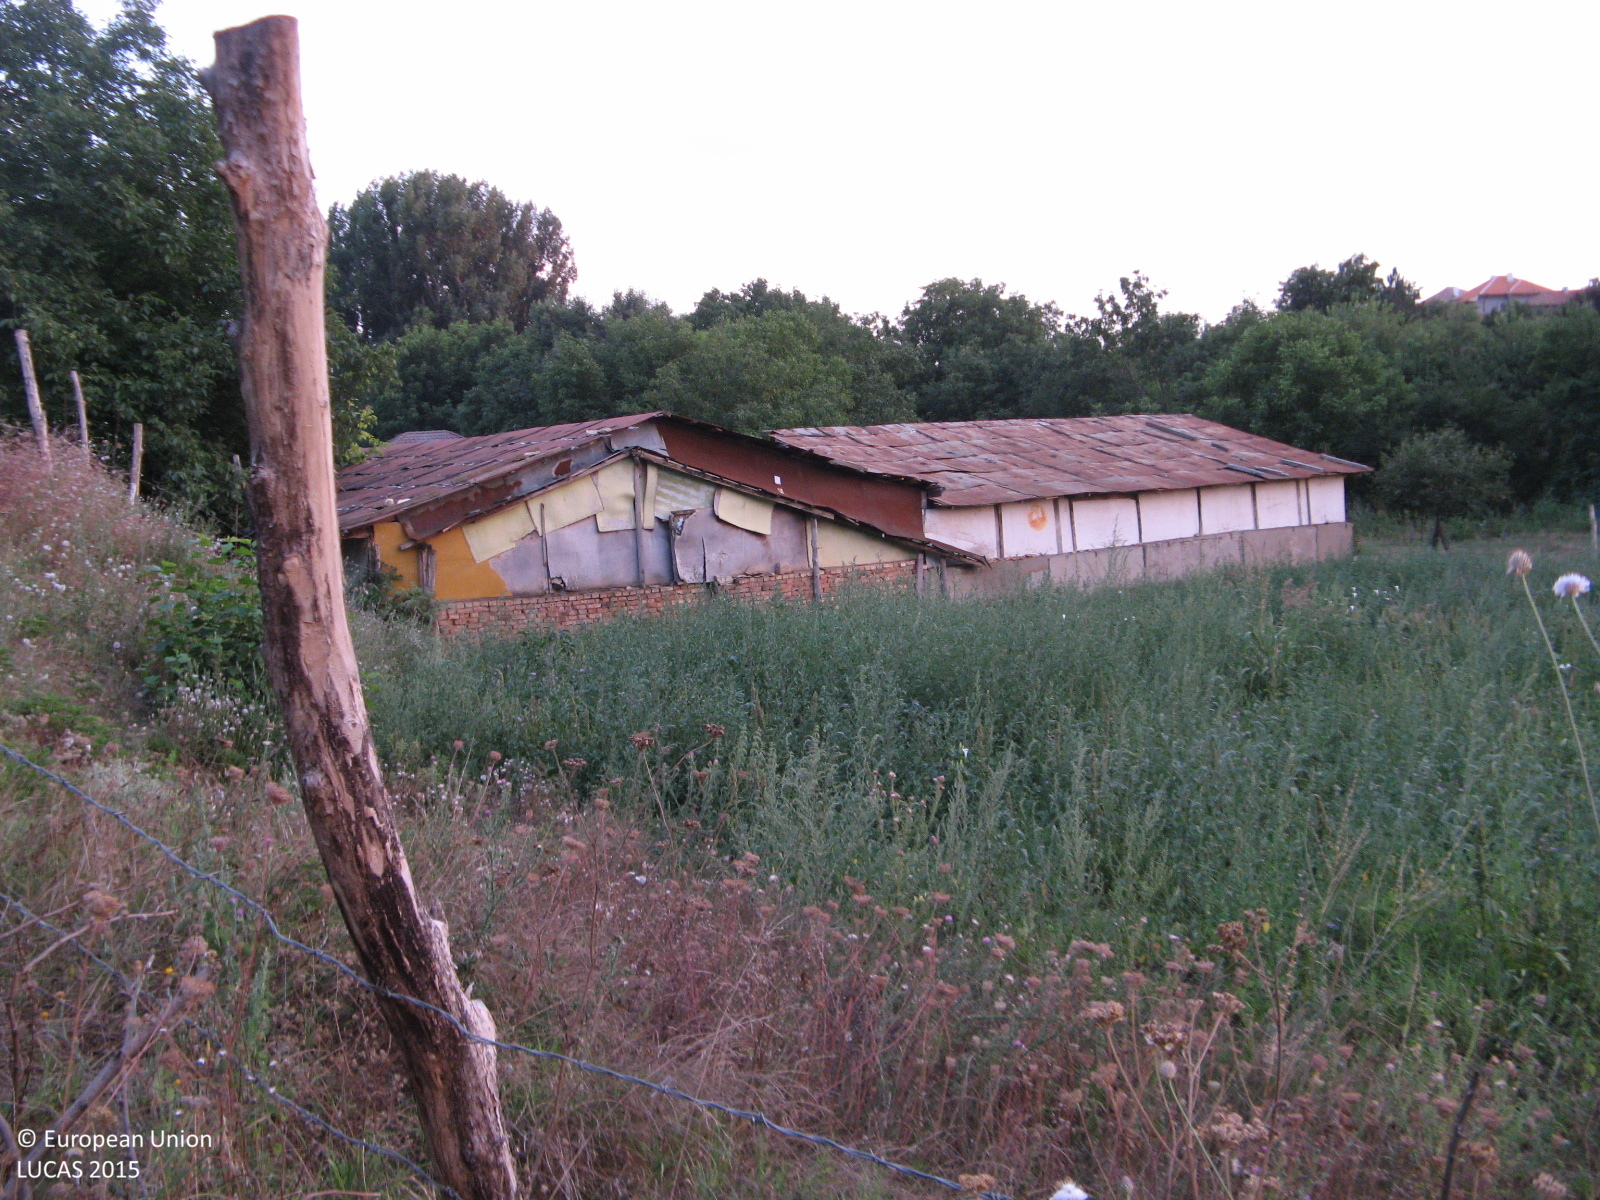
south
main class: Grassland
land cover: Grassland with sparse tree/shrub cover
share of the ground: > 75 %
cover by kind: herbaceous plants 90 %, broadleaved forest trees 5 %, shrubs 5 %
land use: Agriculture (excluding fallow land and kitchen gardens)
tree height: > 5 m
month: August
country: BG
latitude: 43.5949
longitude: 25.8844
